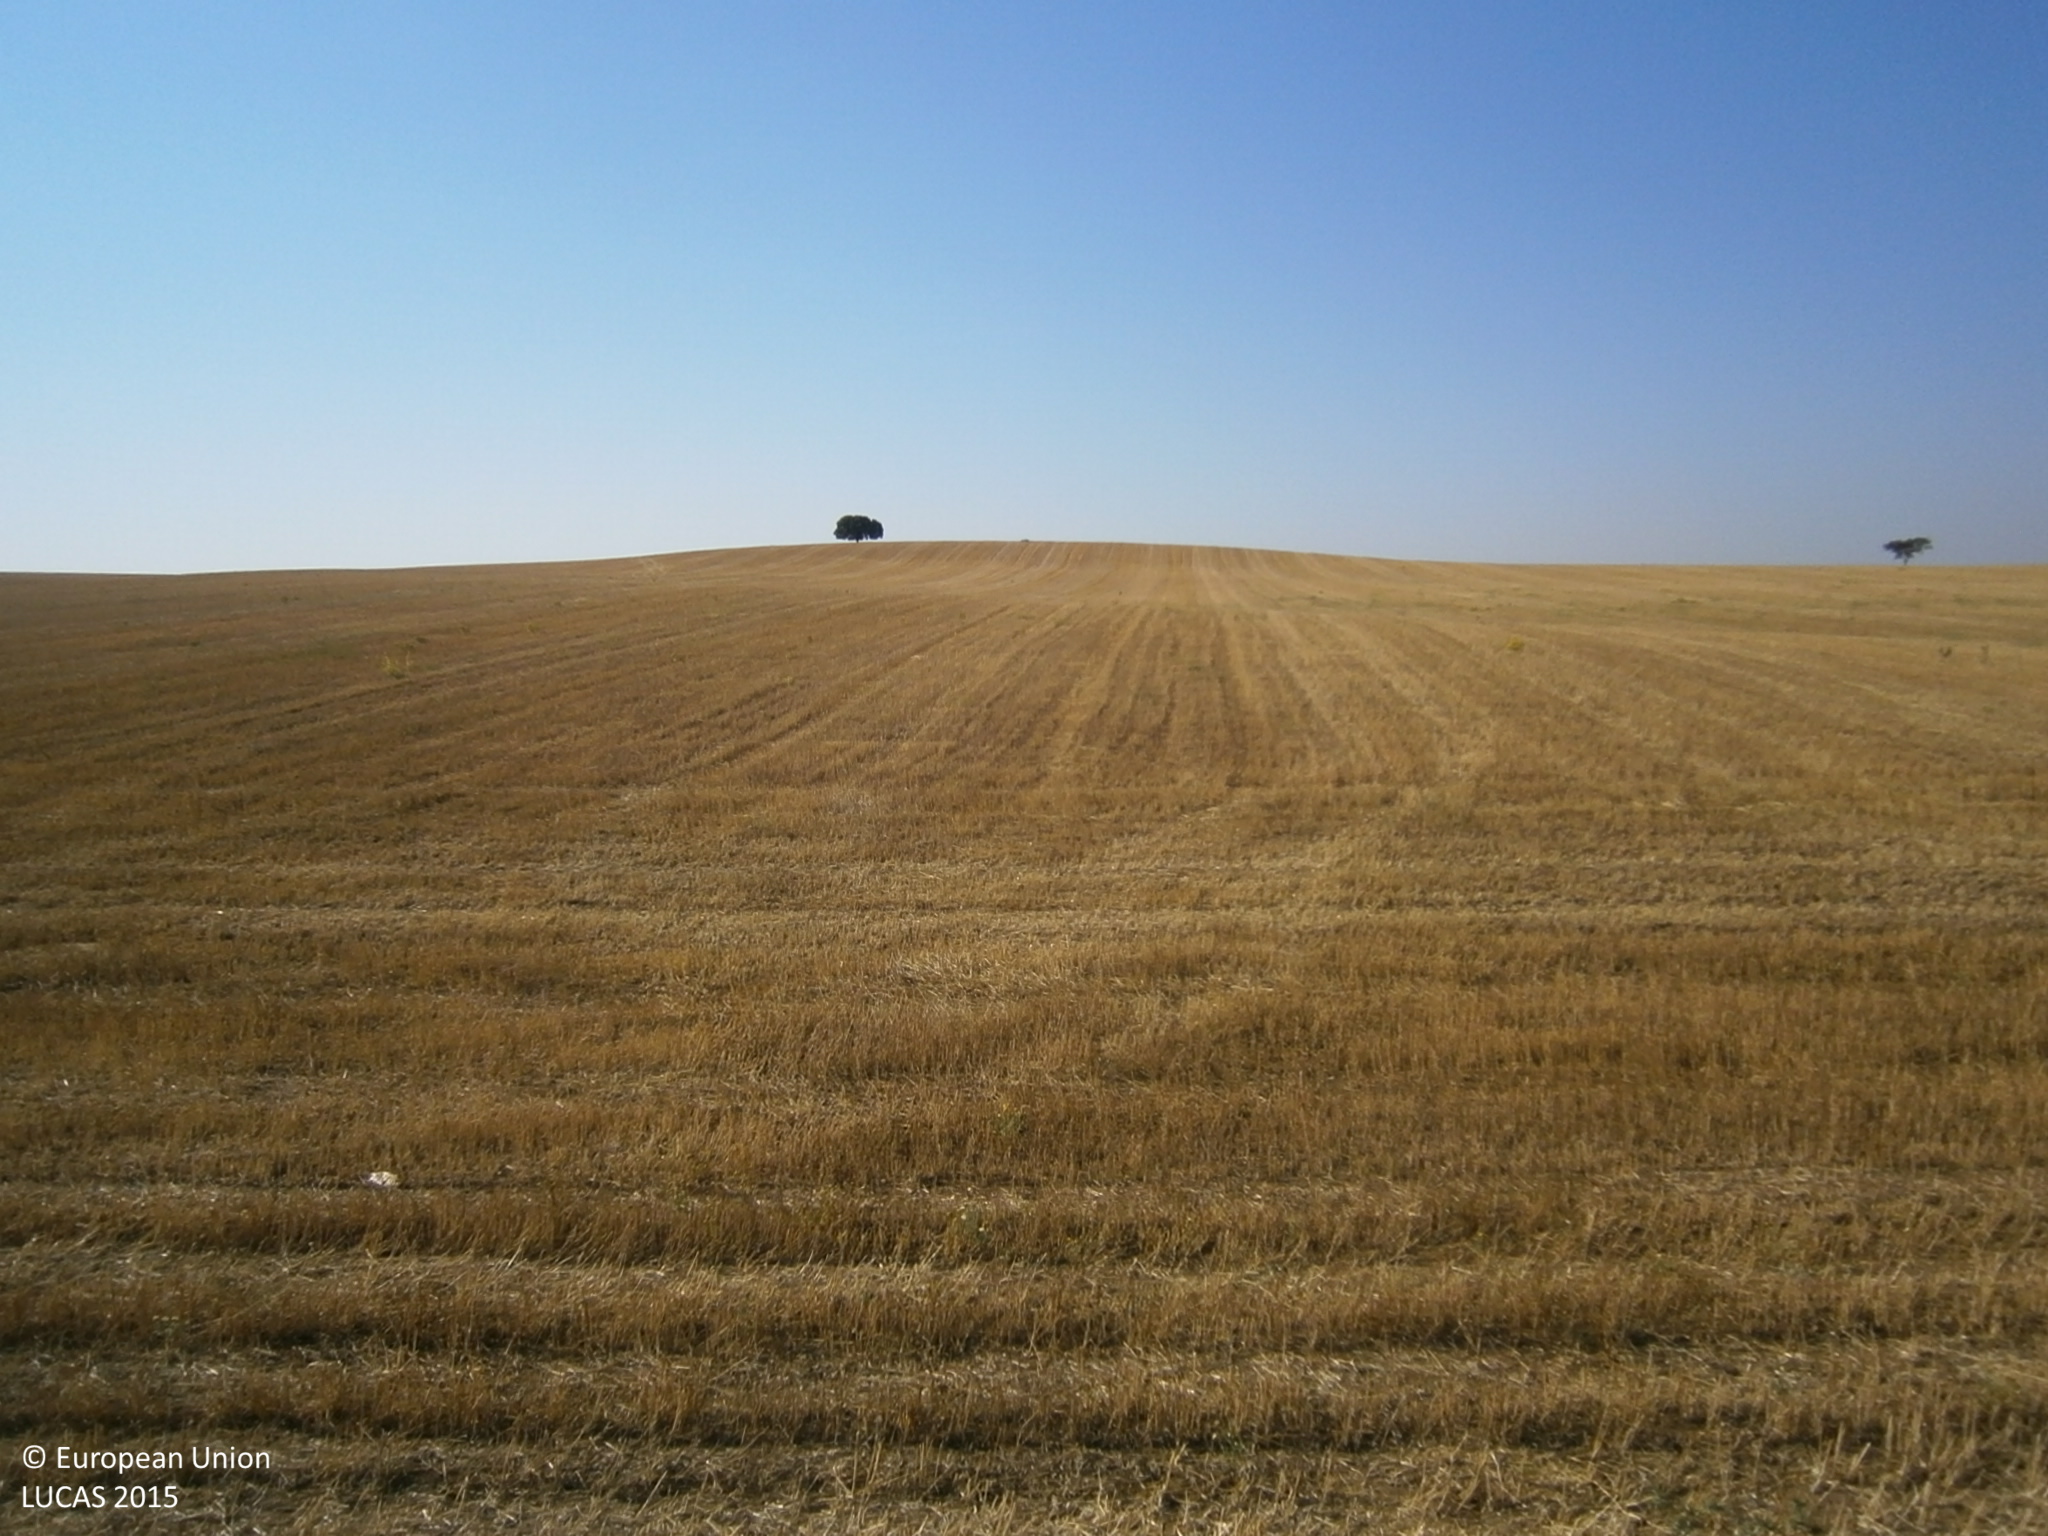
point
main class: Cropland
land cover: Barley
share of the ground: > 75 %
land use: Agriculture (excluding fallow land and kitchen gardens)
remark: Harvested field
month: June
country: ES
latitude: 38.7585
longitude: -6.7609
